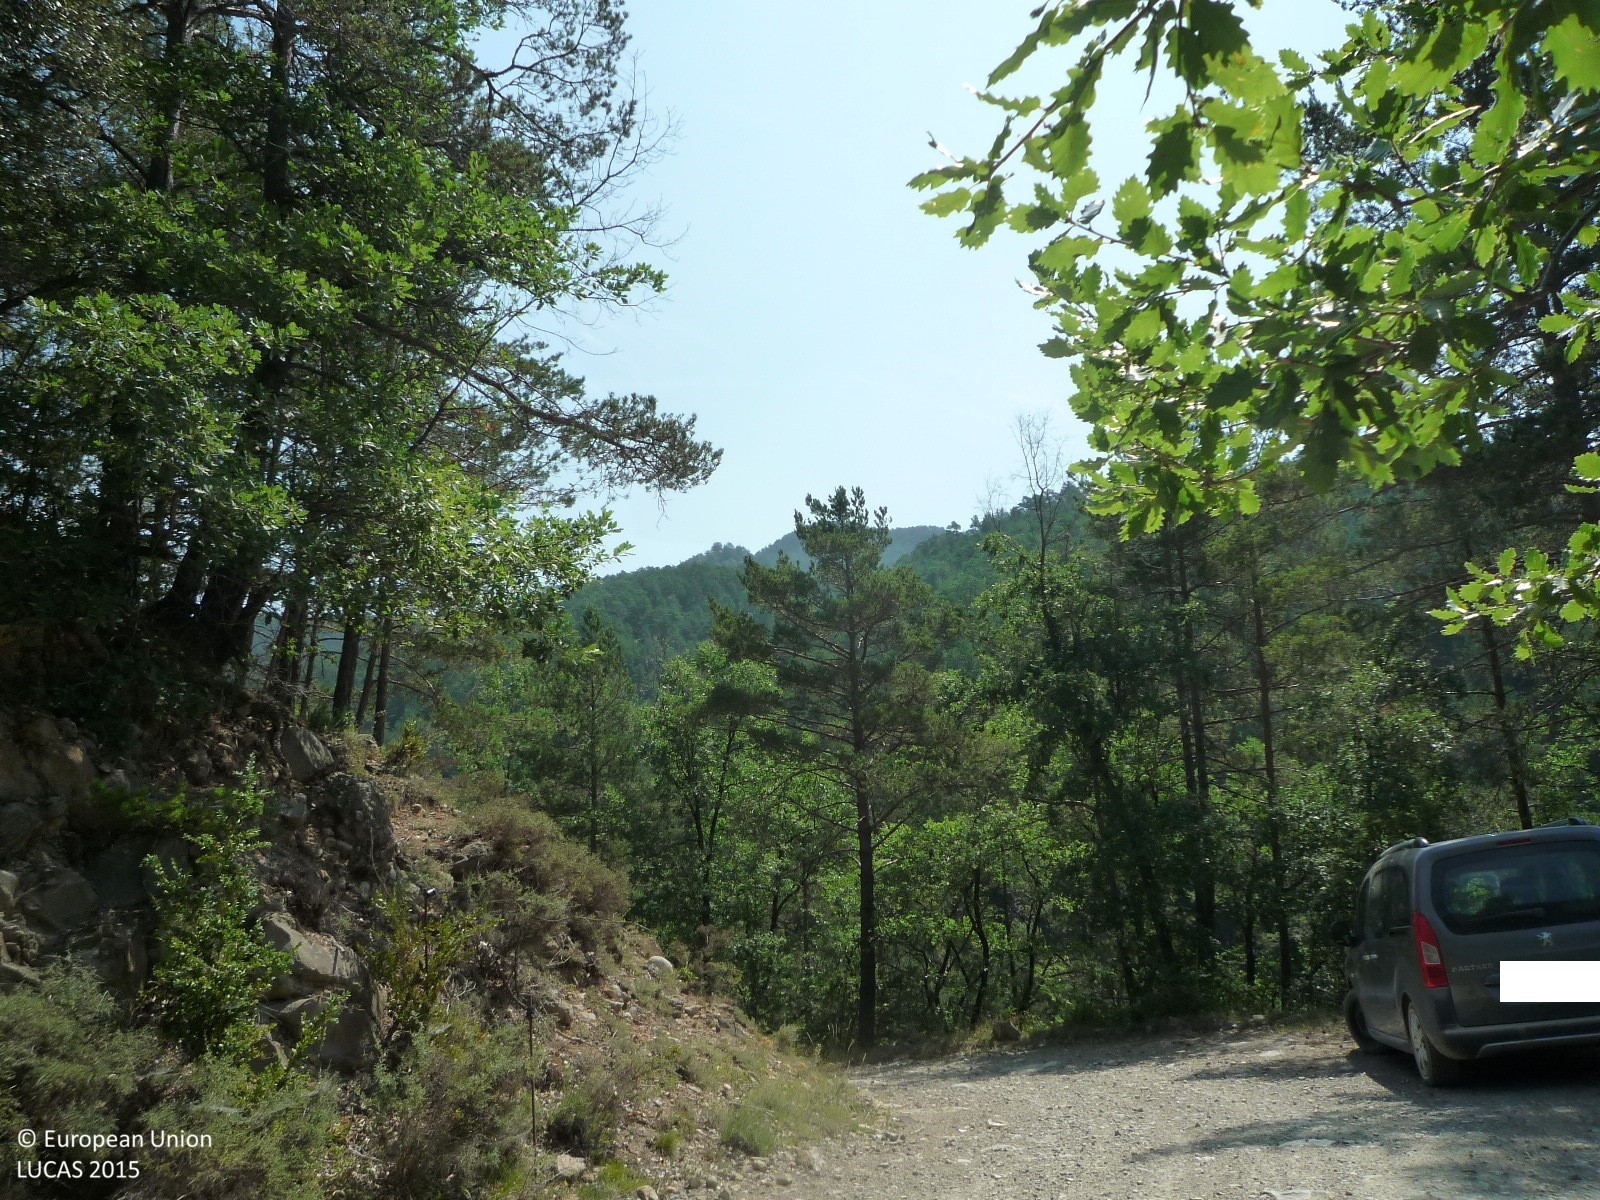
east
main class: Woodland
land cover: Pine dominated mixed woodland
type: coniferous forest of the mediterranean region
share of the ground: > 75 %
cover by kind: coniferous forest trees 55 %, broadleaved forest trees 45 %
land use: Semi-natural and natural areas not in use
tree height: > 5 m
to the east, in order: Pine dominated mixed woodland; Tracks; Other mixed woodland; Rivers and streams; Pine dominated mixed woodland; Tracks; Pine dominated coniferous woodland
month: July
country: ES
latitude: 42.1710
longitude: 1.9628
